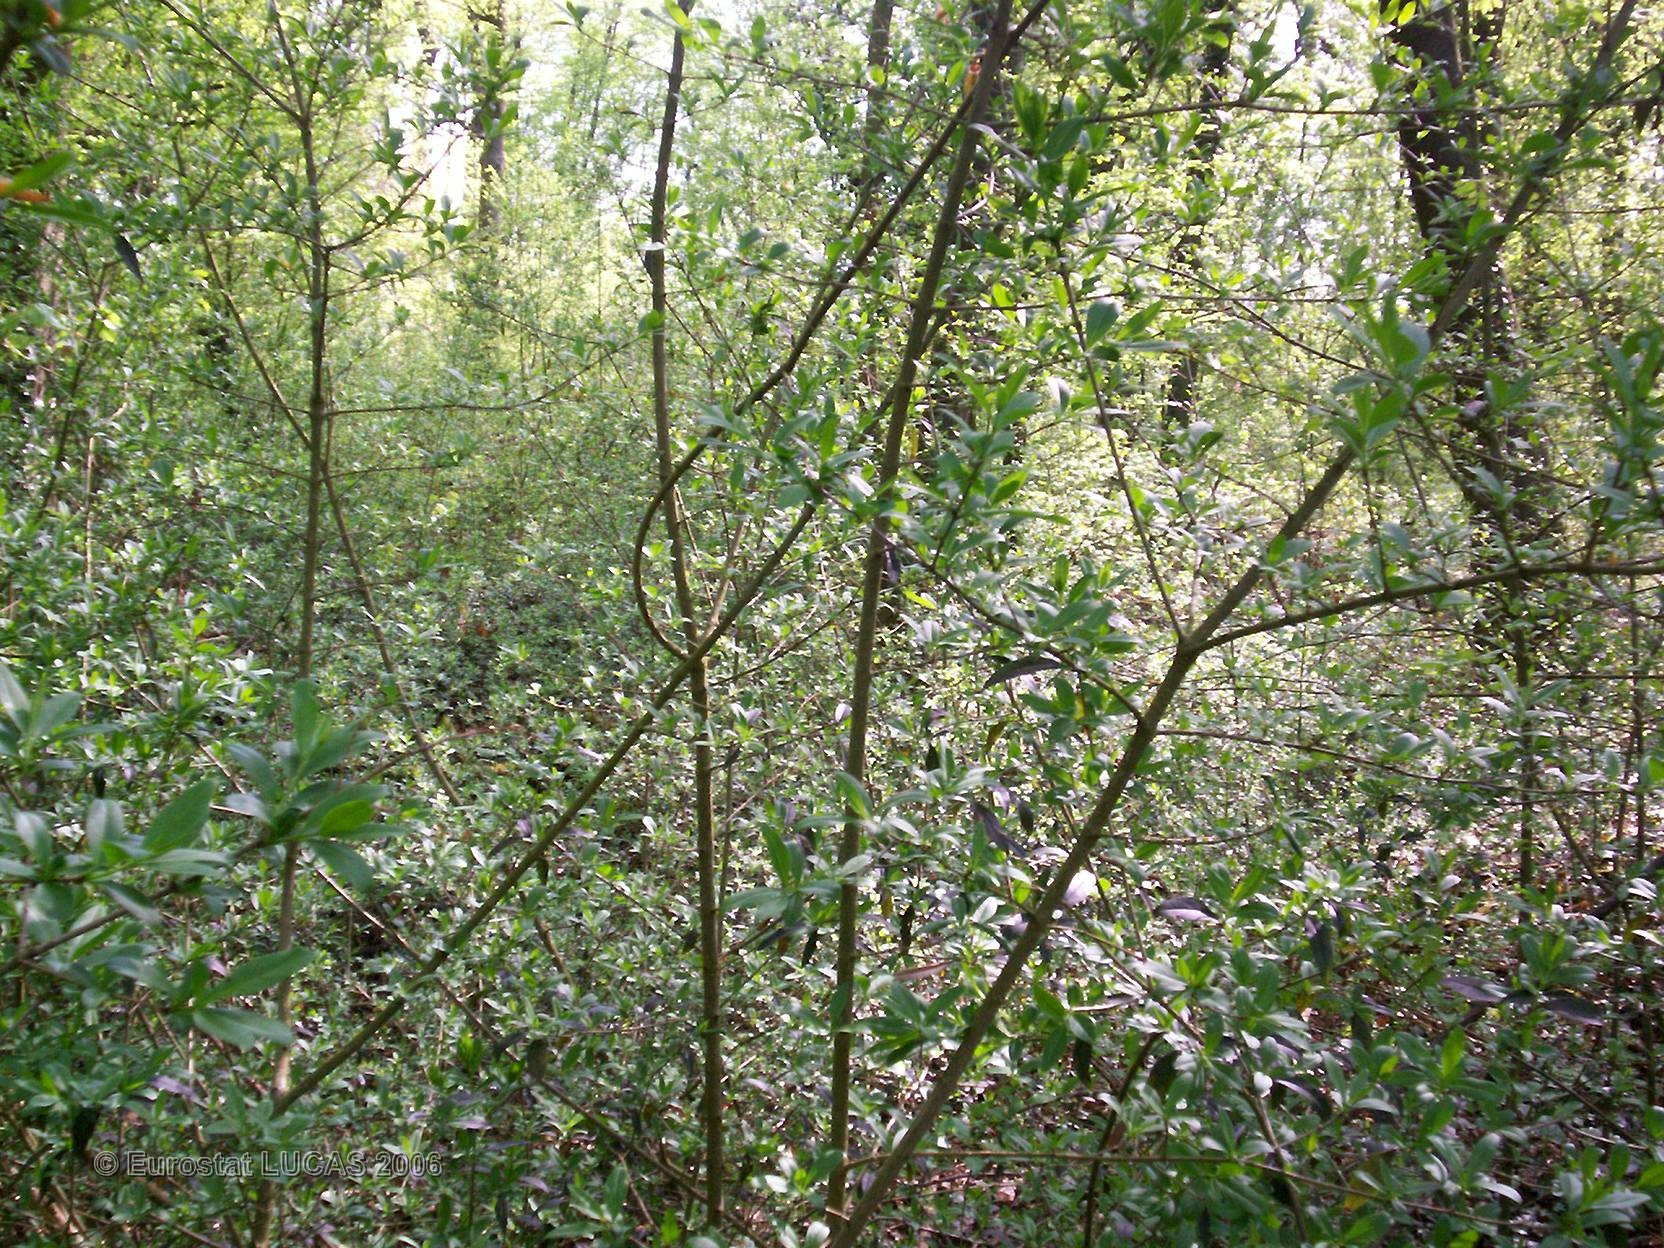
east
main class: Woodland
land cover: Broadleaved forest
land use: Forestry
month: April
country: FR
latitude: 49.0230
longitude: 6.7866
